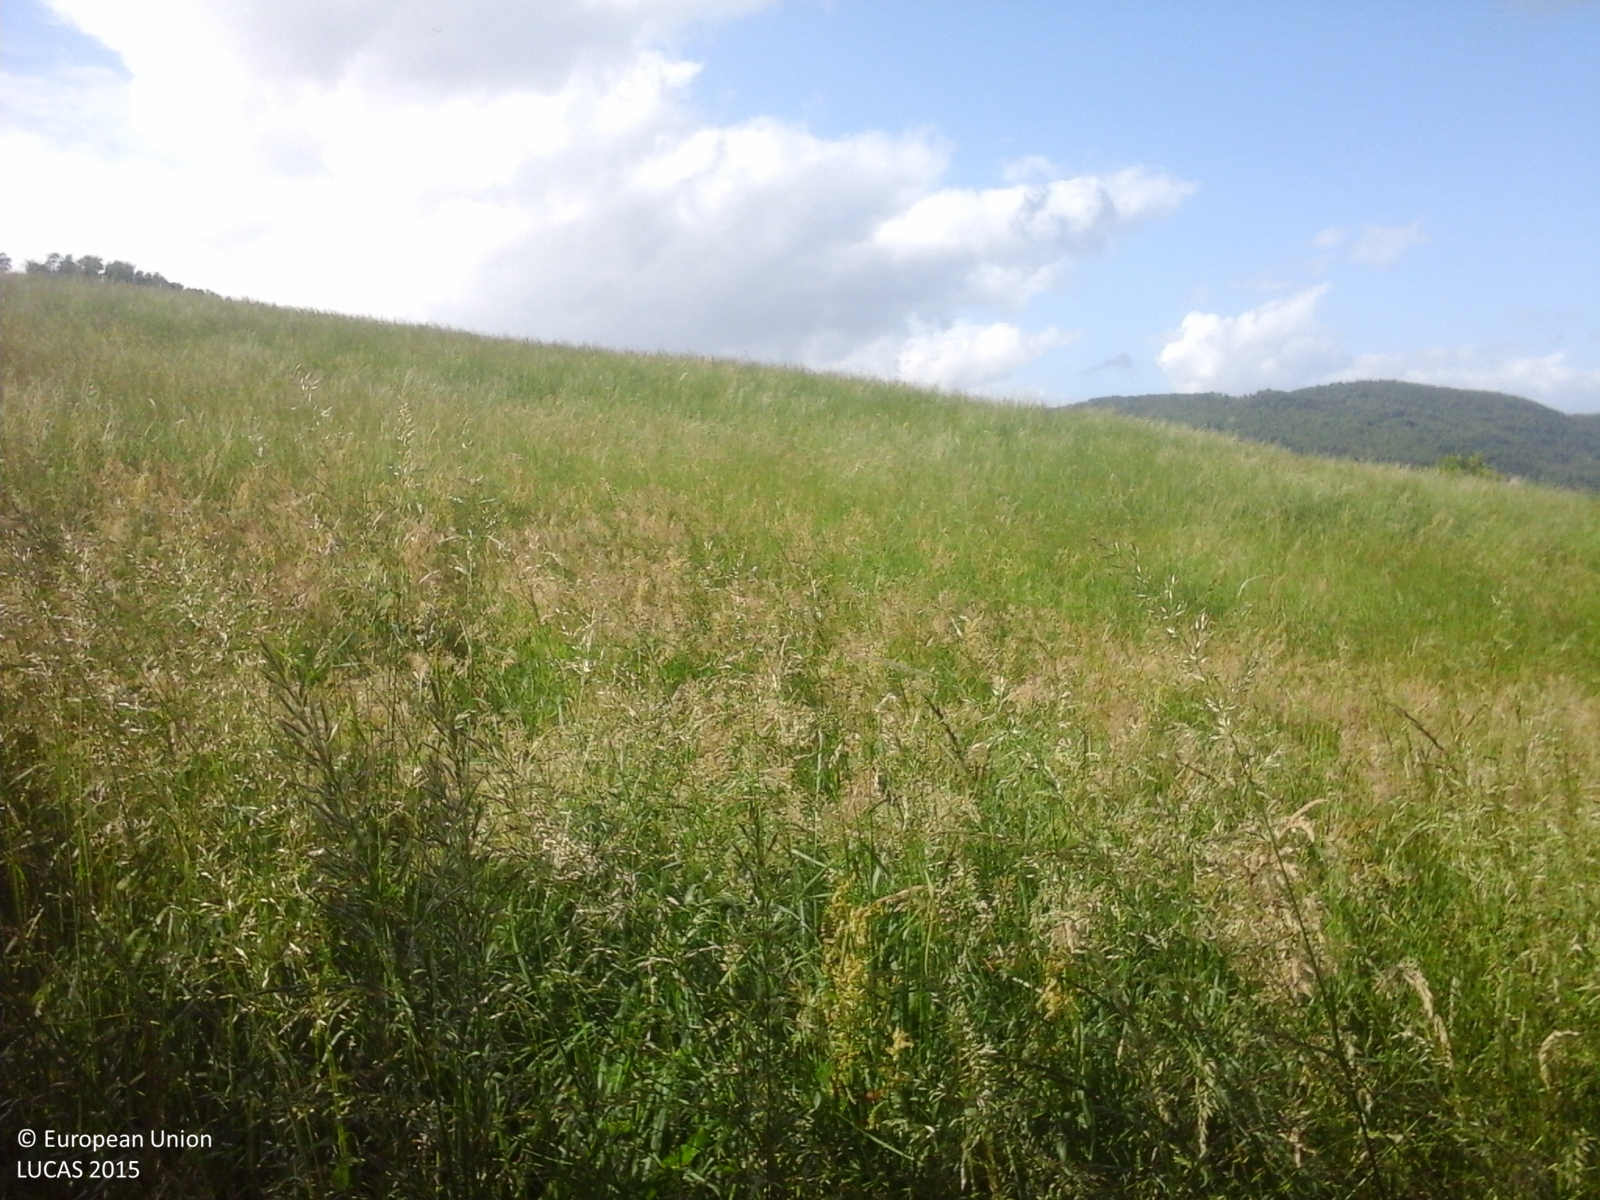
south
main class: Woodland
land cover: Broadleaved woodland
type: thermophilous deciduous forest
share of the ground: > 75 %
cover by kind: broadleaved forest trees 90 %, shrubs 10 %
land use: Forestry
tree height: > 5 m
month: May
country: IT
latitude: 44.3451
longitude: 11.0638
